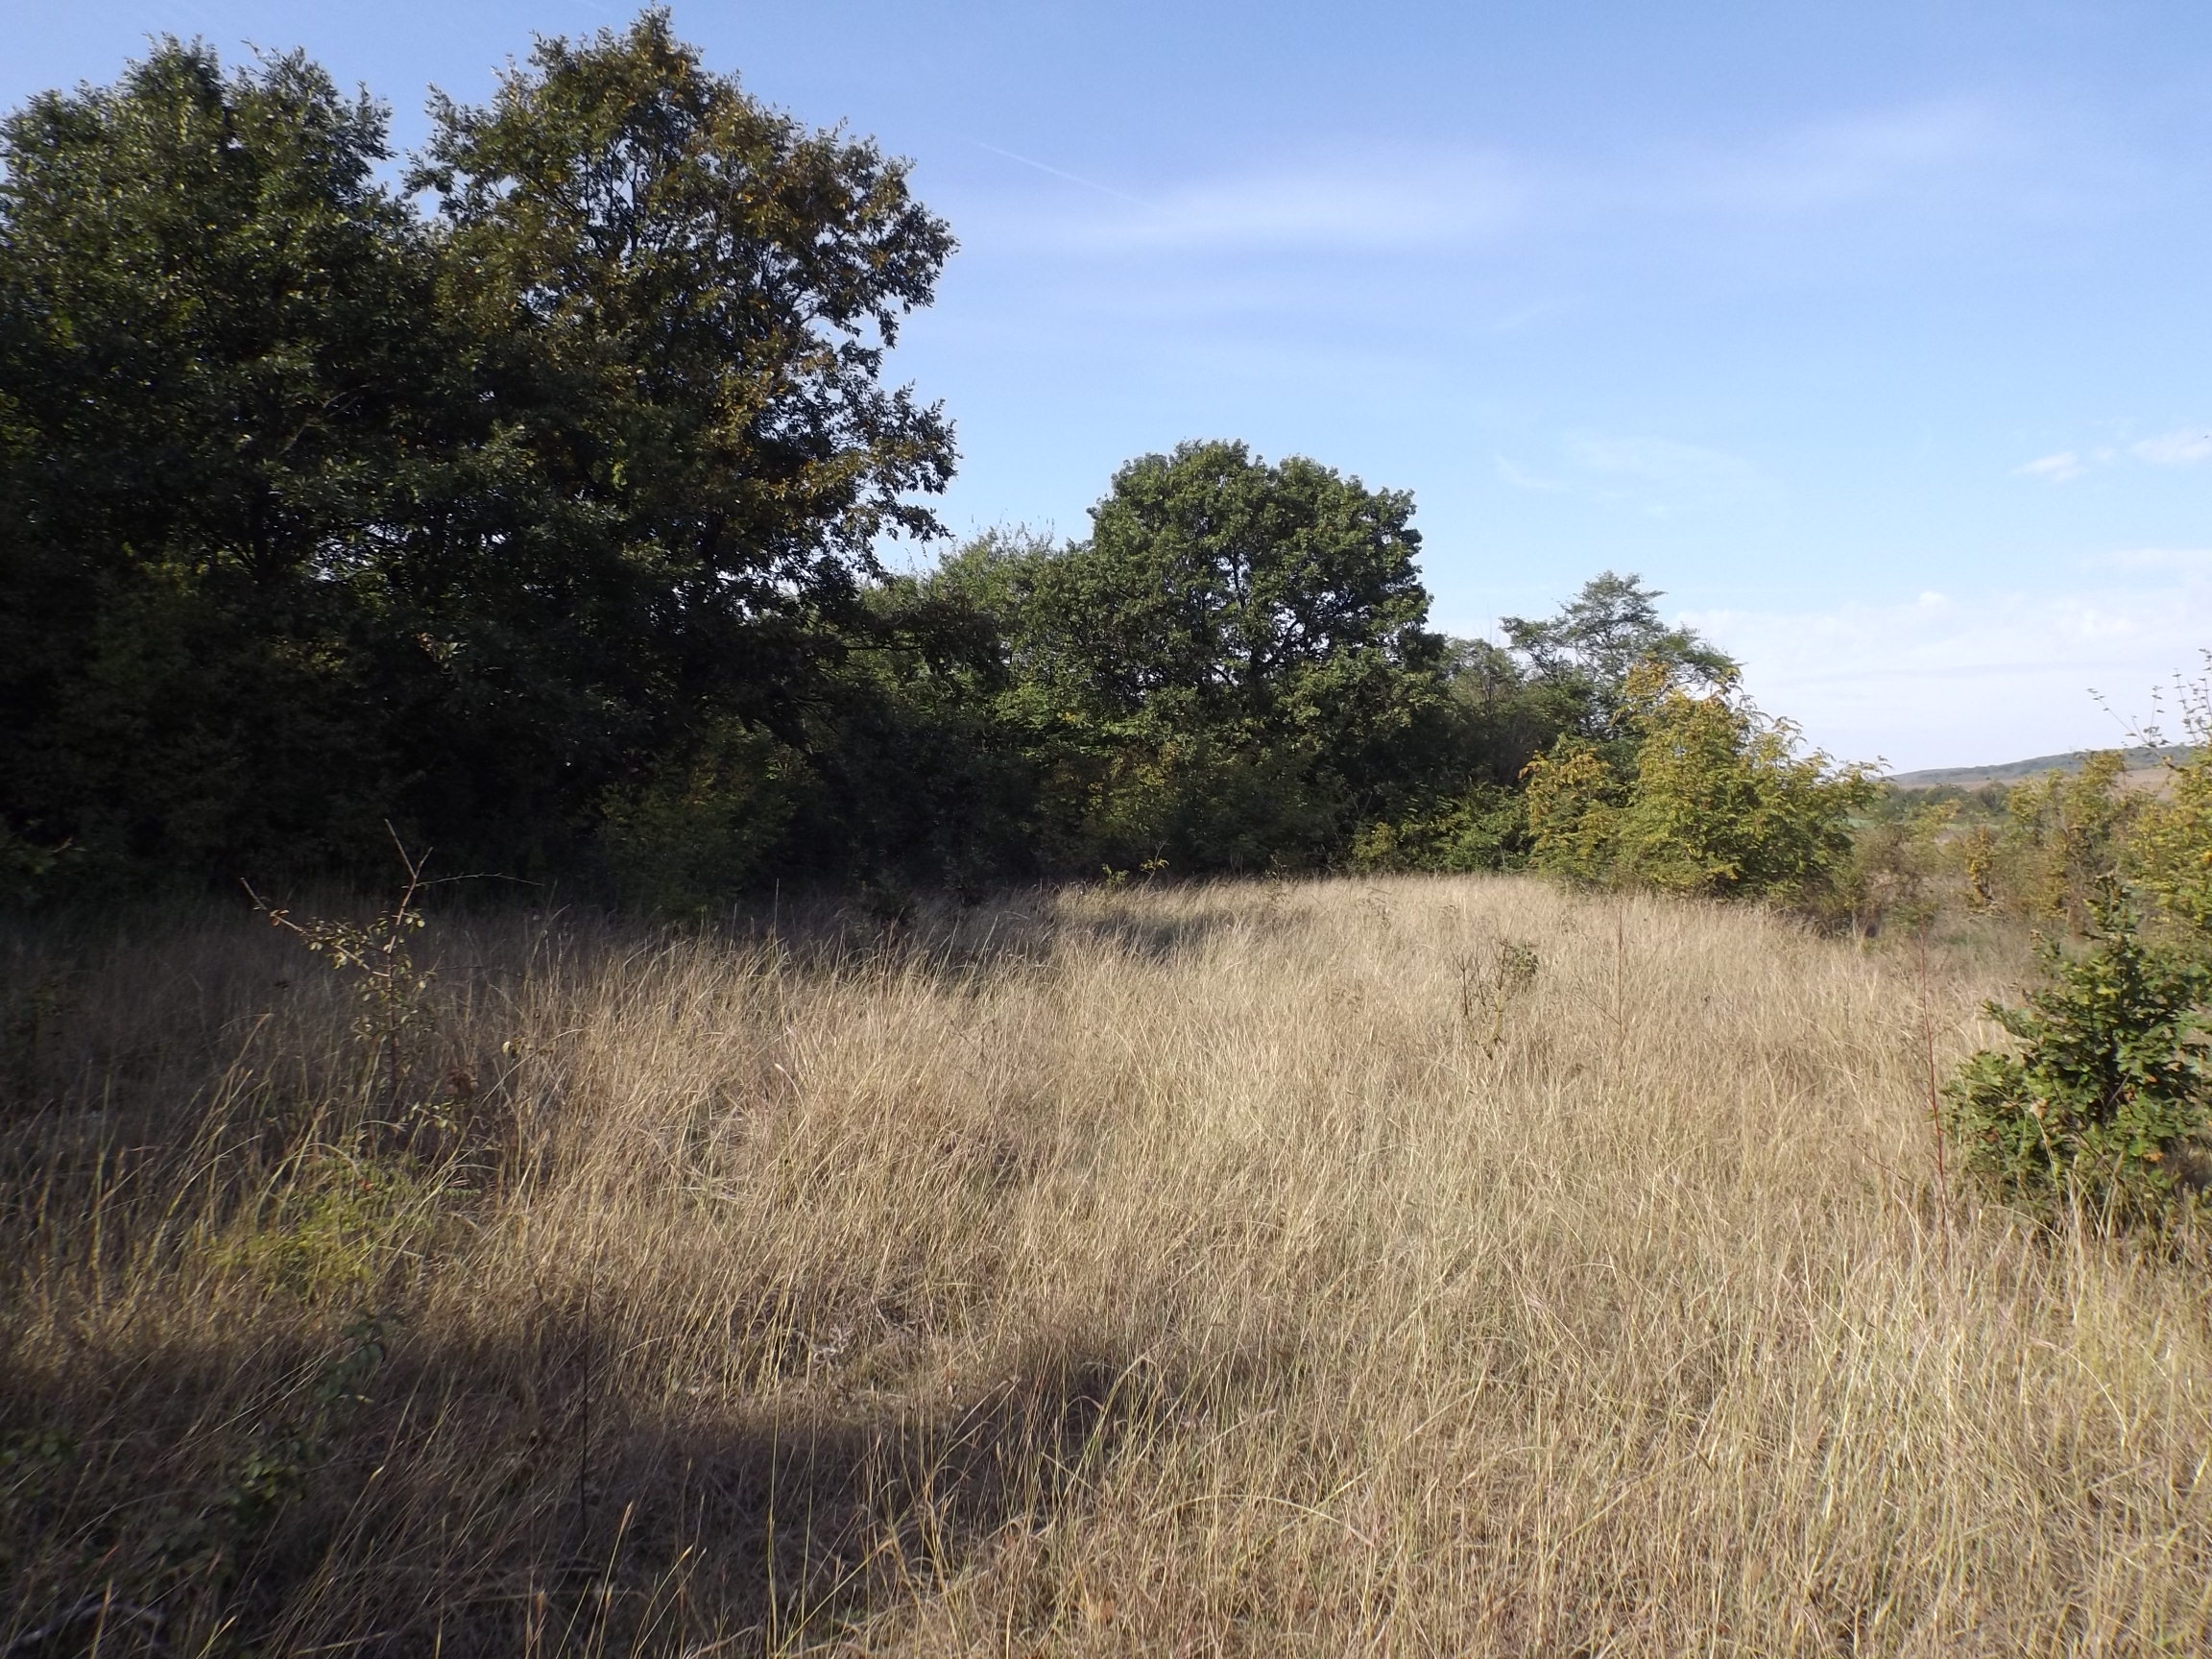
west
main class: Grassland
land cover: Grassland with sparse tree/shrub cover
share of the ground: > 75 %
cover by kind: herbaceous plants 90 %, broadleaved forest trees 5 %, shrubs 5 %
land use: Semi-natural and natural areas not in use
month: October
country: BG
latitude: 43.1546
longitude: 27.2251
